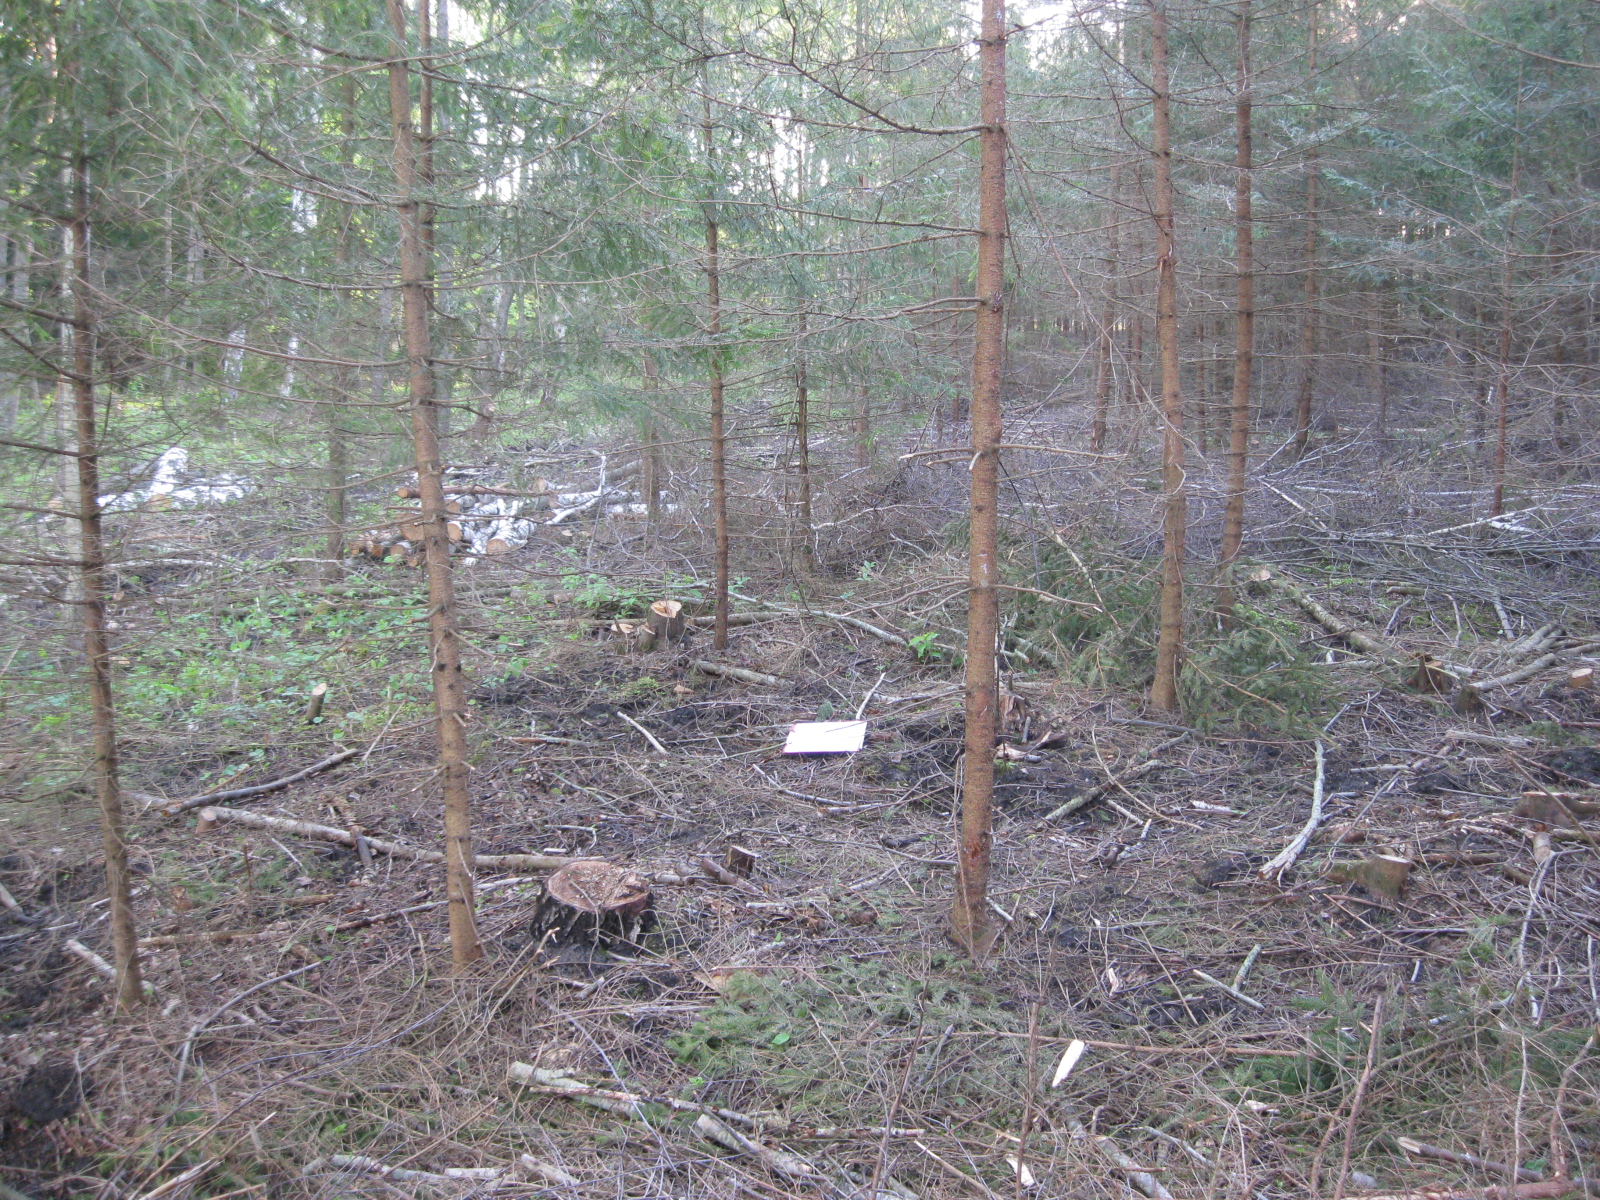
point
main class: Woodland
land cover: Spruce dominated coniferous woodland
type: hemiboreal forest and nemoral coniferous forest and mixed broadleaved-coniferous forest
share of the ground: 50 - 75 %
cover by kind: coniferous forest trees 70 %, unconsolidated bare surface 10 %, herbaceous plants 5 %
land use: Forestry
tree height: > 5 m
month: May
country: LT
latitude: 56.0308
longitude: 24.8539
